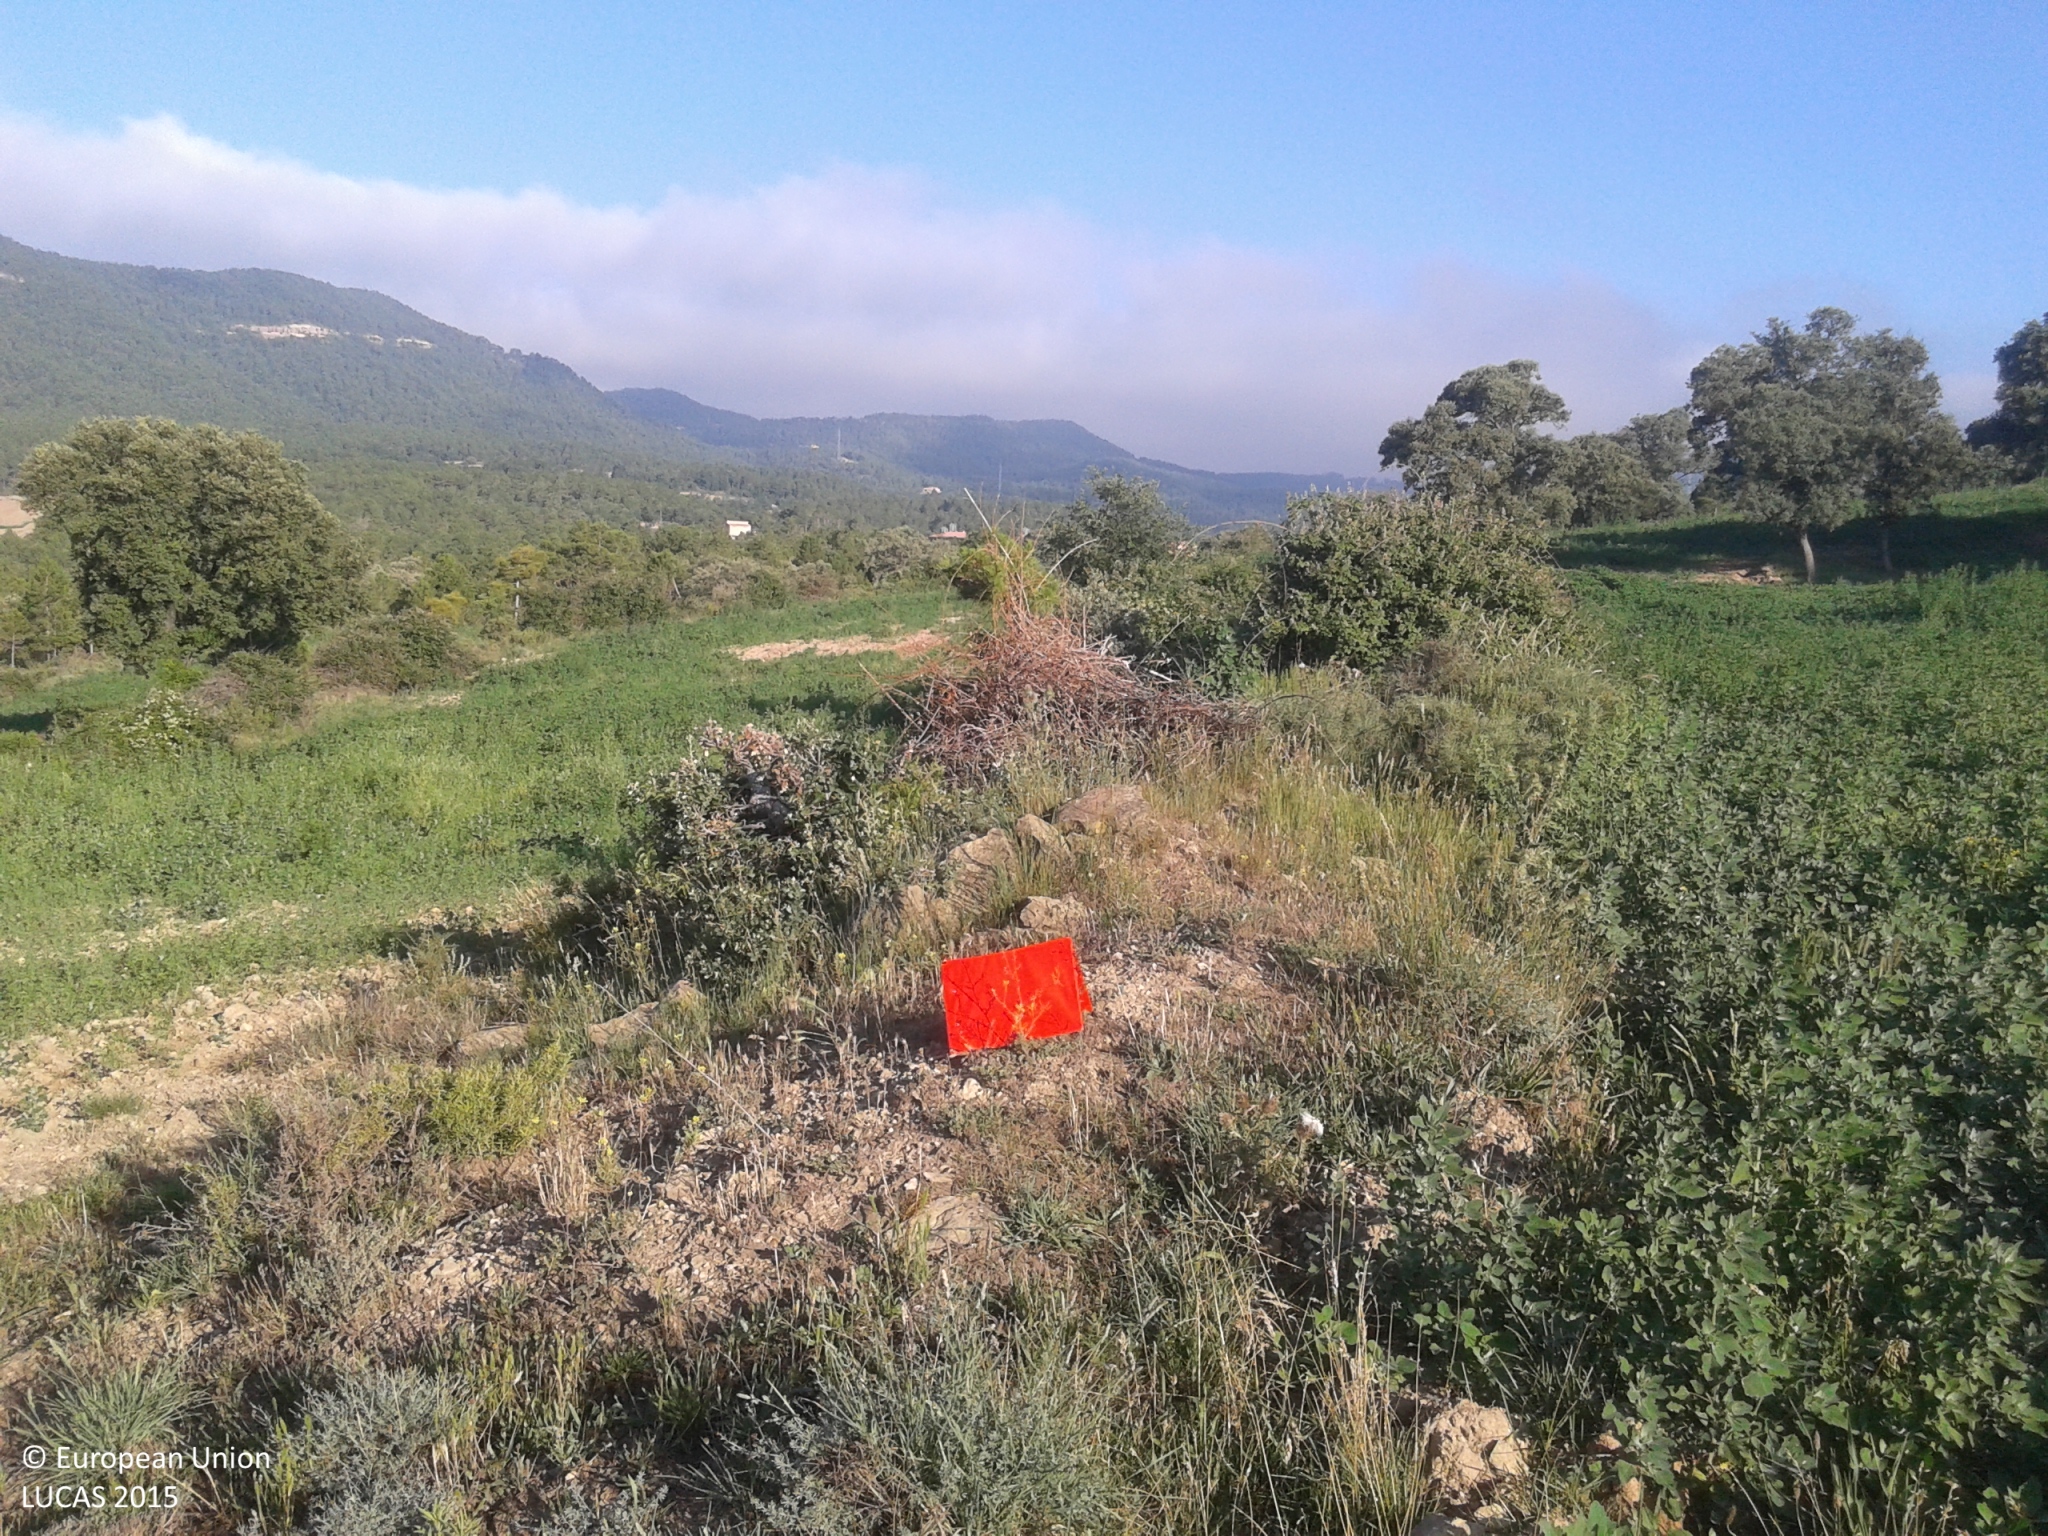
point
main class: Cropland
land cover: Temporary grasslands
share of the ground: > 75 %
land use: Agriculture (excluding fallow land and kitchen gardens)
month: June
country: ES
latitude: 42.0278
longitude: 1.5457
